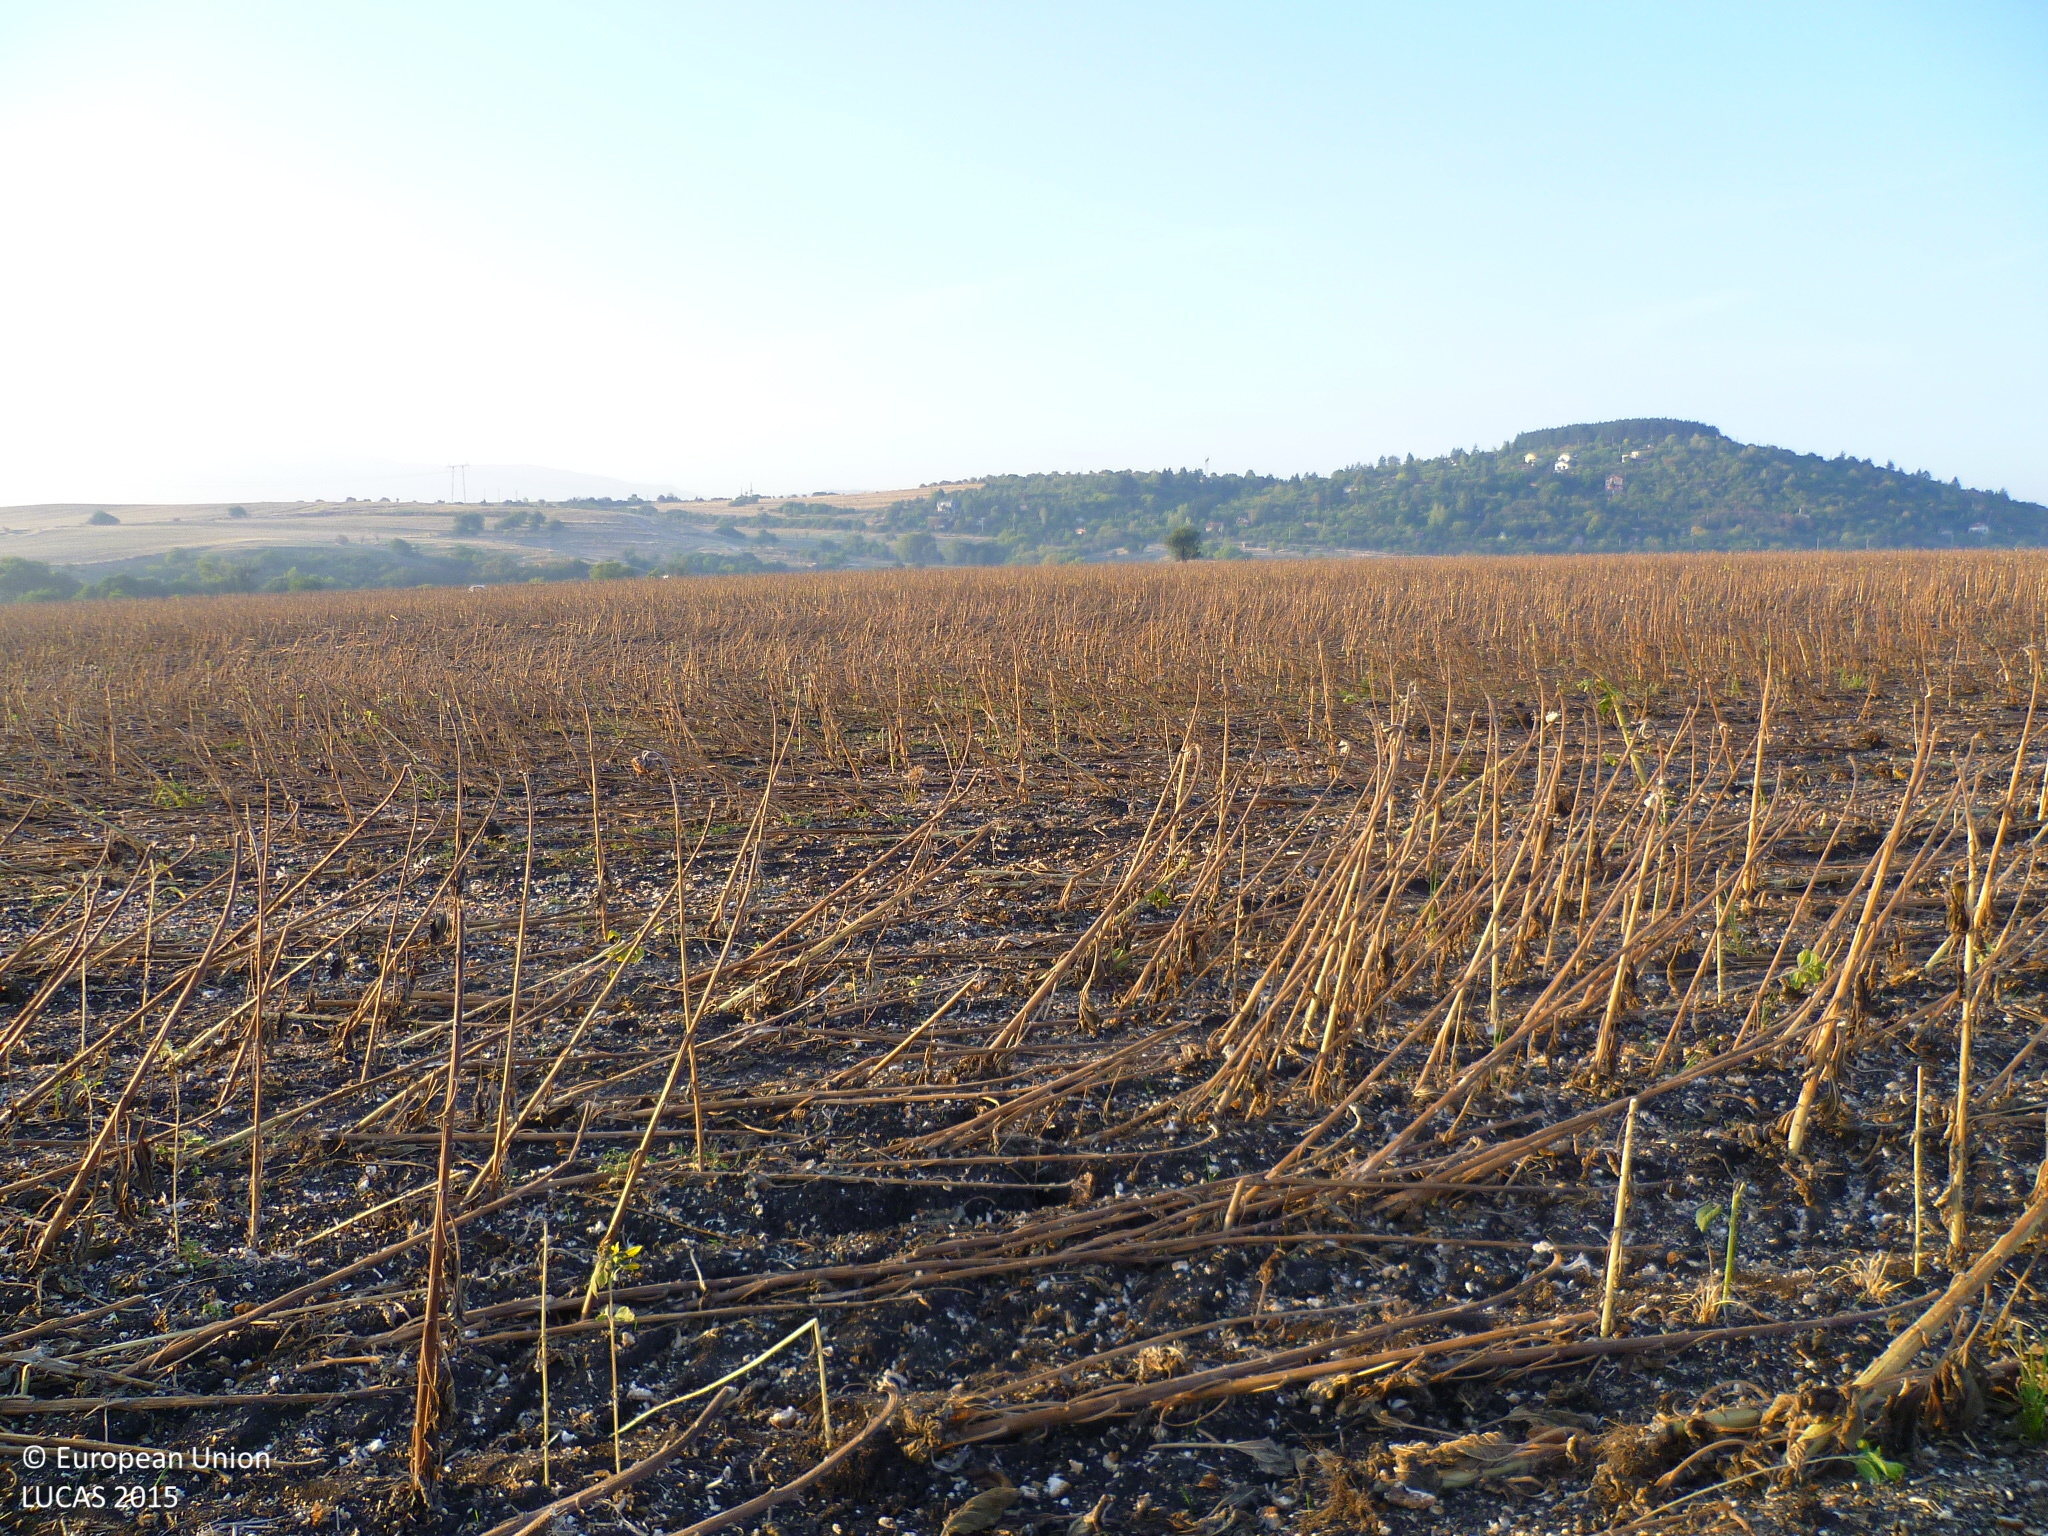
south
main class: Cropland
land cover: Sunflower
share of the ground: 25 - 50 %
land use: Agriculture (excluding fallow land and kitchen gardens)
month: September
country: BG
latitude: 42.7617
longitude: 23.1440
